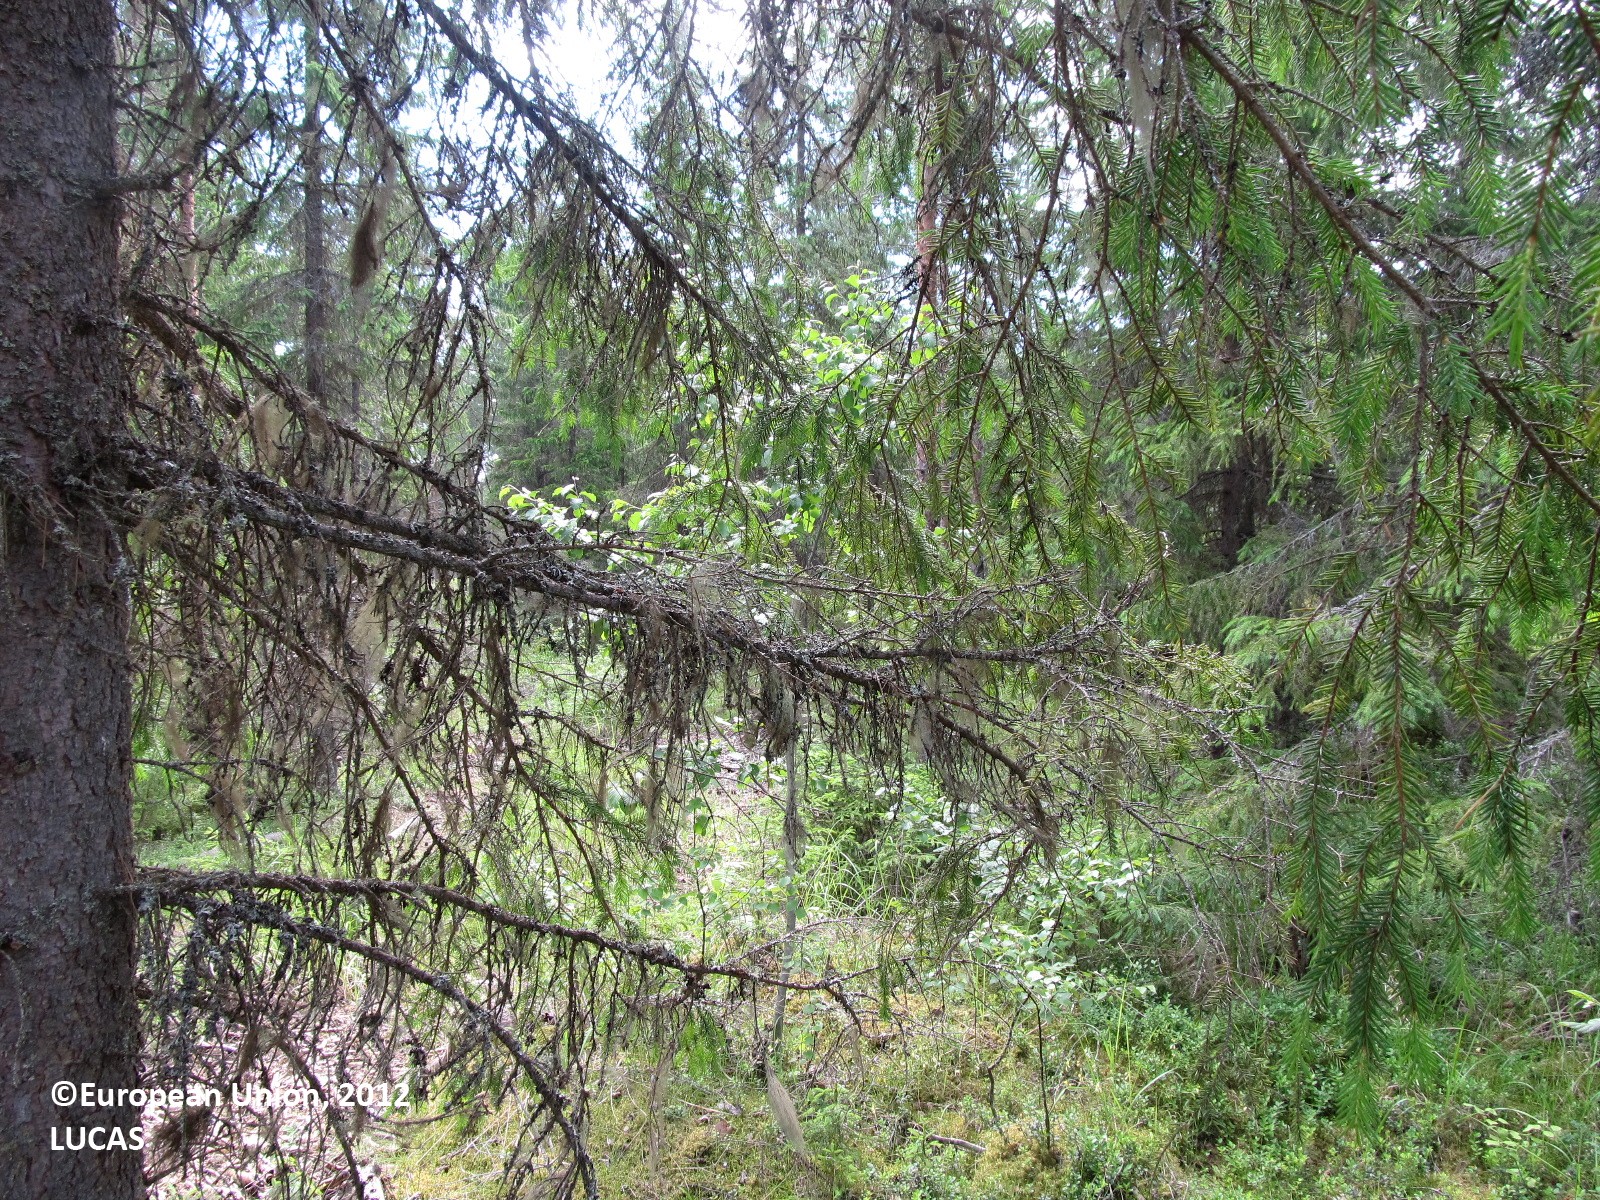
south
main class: Woodland
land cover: Spruce dominated coniferous woodland
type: boreal forest
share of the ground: 50 - 75 %
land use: Forestry
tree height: > 5 m
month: July
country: FI
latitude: 62.4395
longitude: 28.9124
